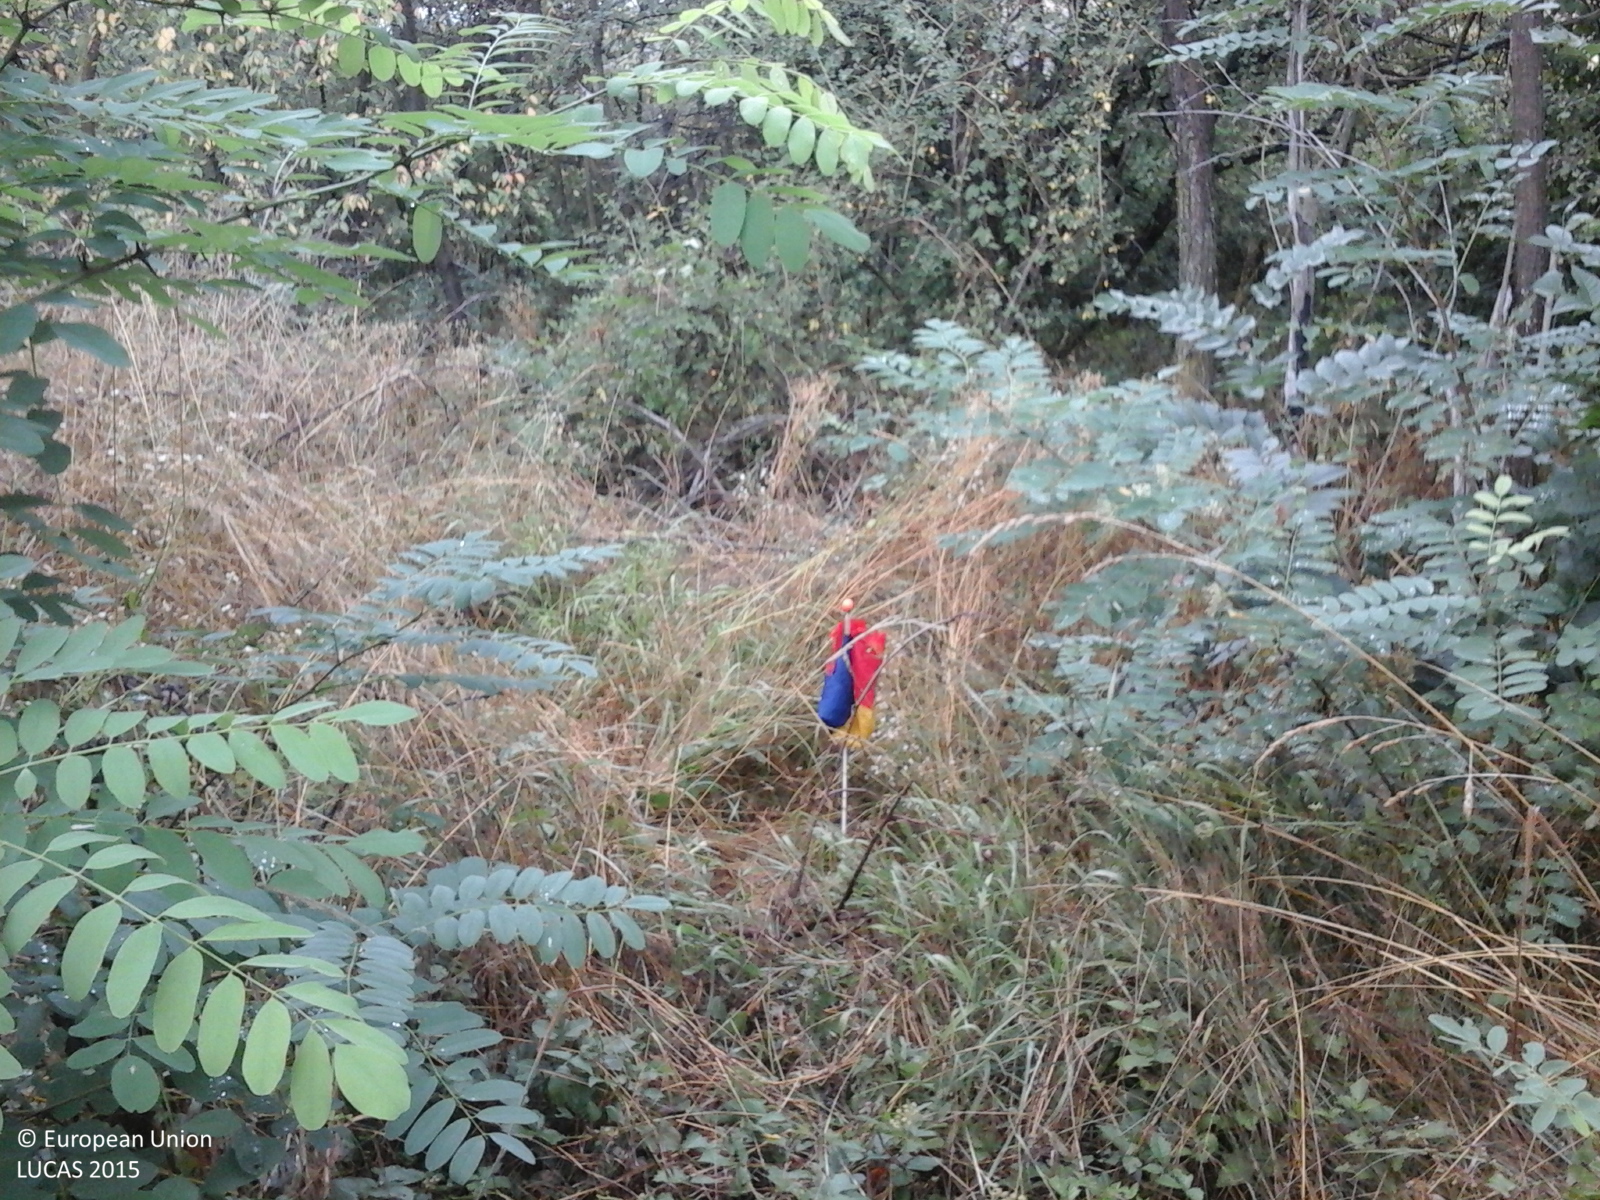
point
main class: Woodland
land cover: Broadleaved woodland
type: exotic forest
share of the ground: > 75 %
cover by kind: broadleaved forest trees 100 %
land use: Forestry
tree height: > 5 m
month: August
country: RO
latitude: 44.8962
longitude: 22.1038
